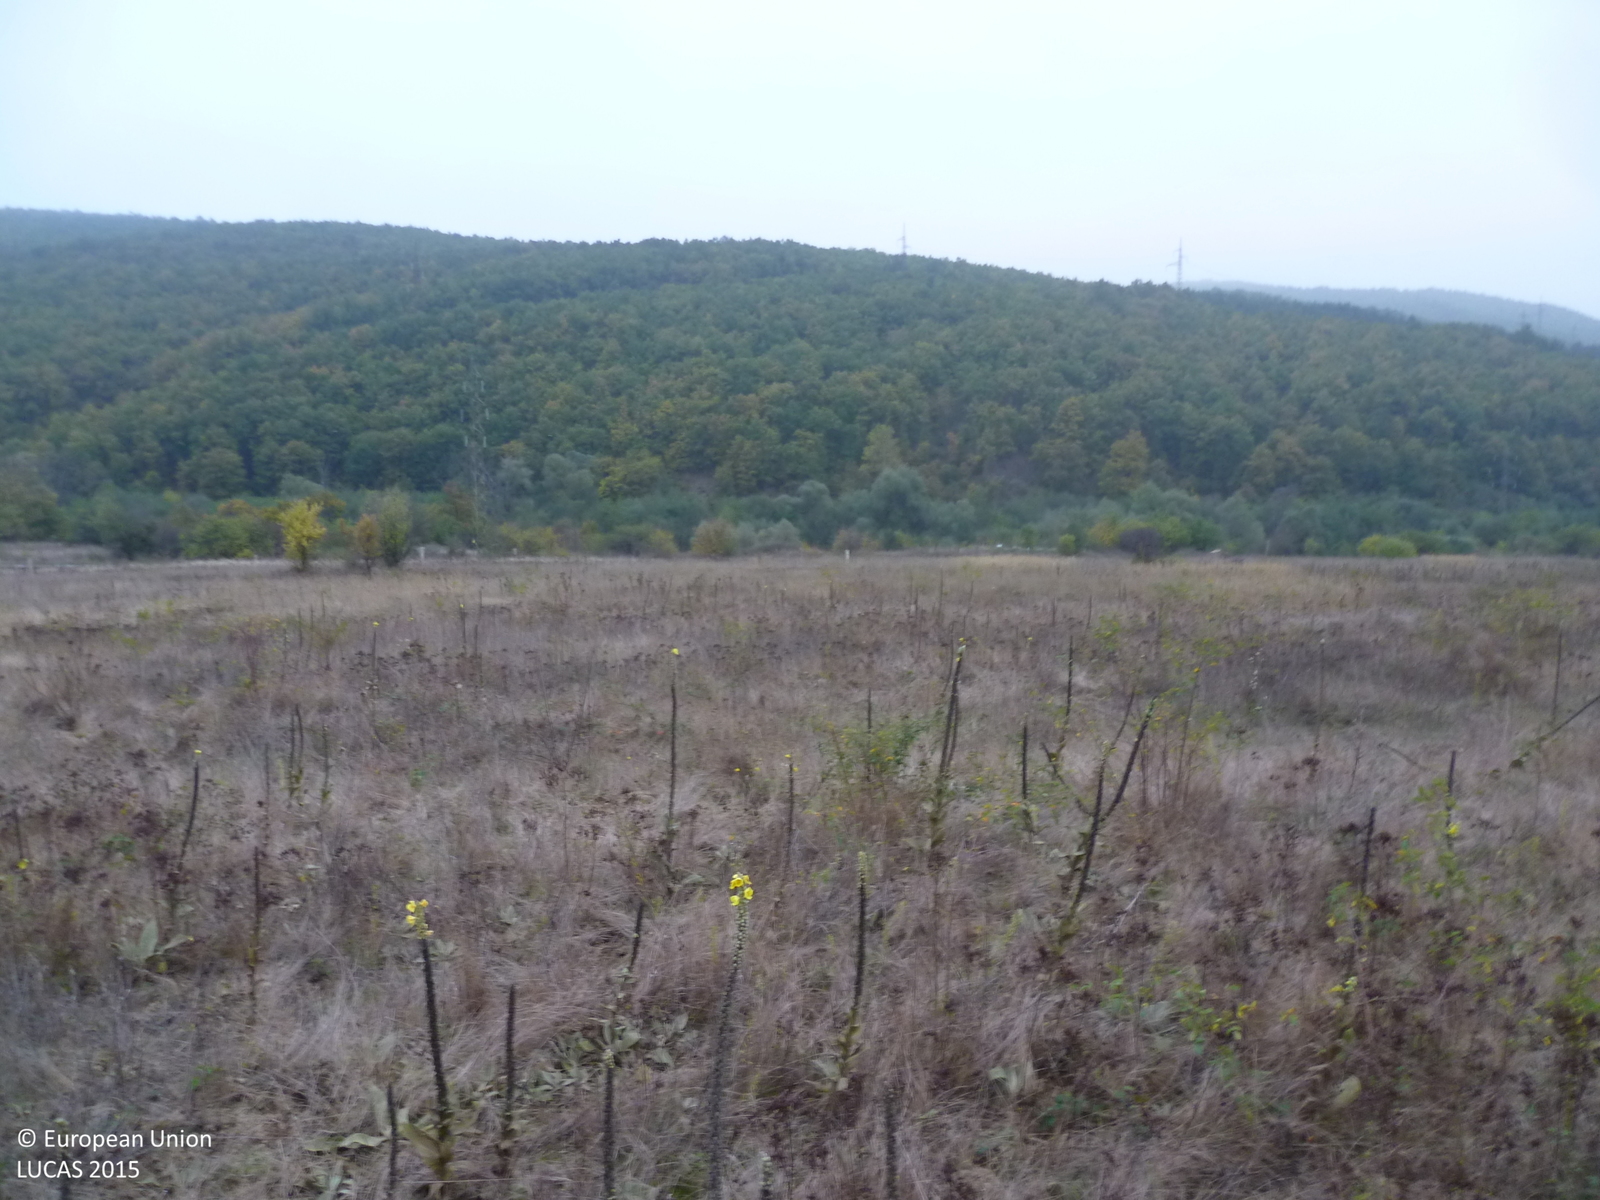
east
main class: Grassland
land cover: Grassland with sparse tree/shrub cover
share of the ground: > 75 %
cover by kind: herbaceous plants 90 %, broadleaved forest trees 5 %, shrubs 5 %
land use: Agriculture (excluding fallow land and kitchen gardens)
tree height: < 5 m
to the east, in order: Grassland with sparse tree/shrub cover; Grassland without tree/shrub cover; Single bushes/trees; Ditches and canals; Grass margins; Paved roads, cycling and walking lanes; Grassland with sparse tree/shrub cover; Tracks; Grassland with sparse tree/shrub cover; Tracks; Grassland with sparse tree/shrub cover; Electric lines; Shrubland with sparse tree cover; Grassland with sparse tree/shrub cover
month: October
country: BG
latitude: 42.5152
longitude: 23.7562
